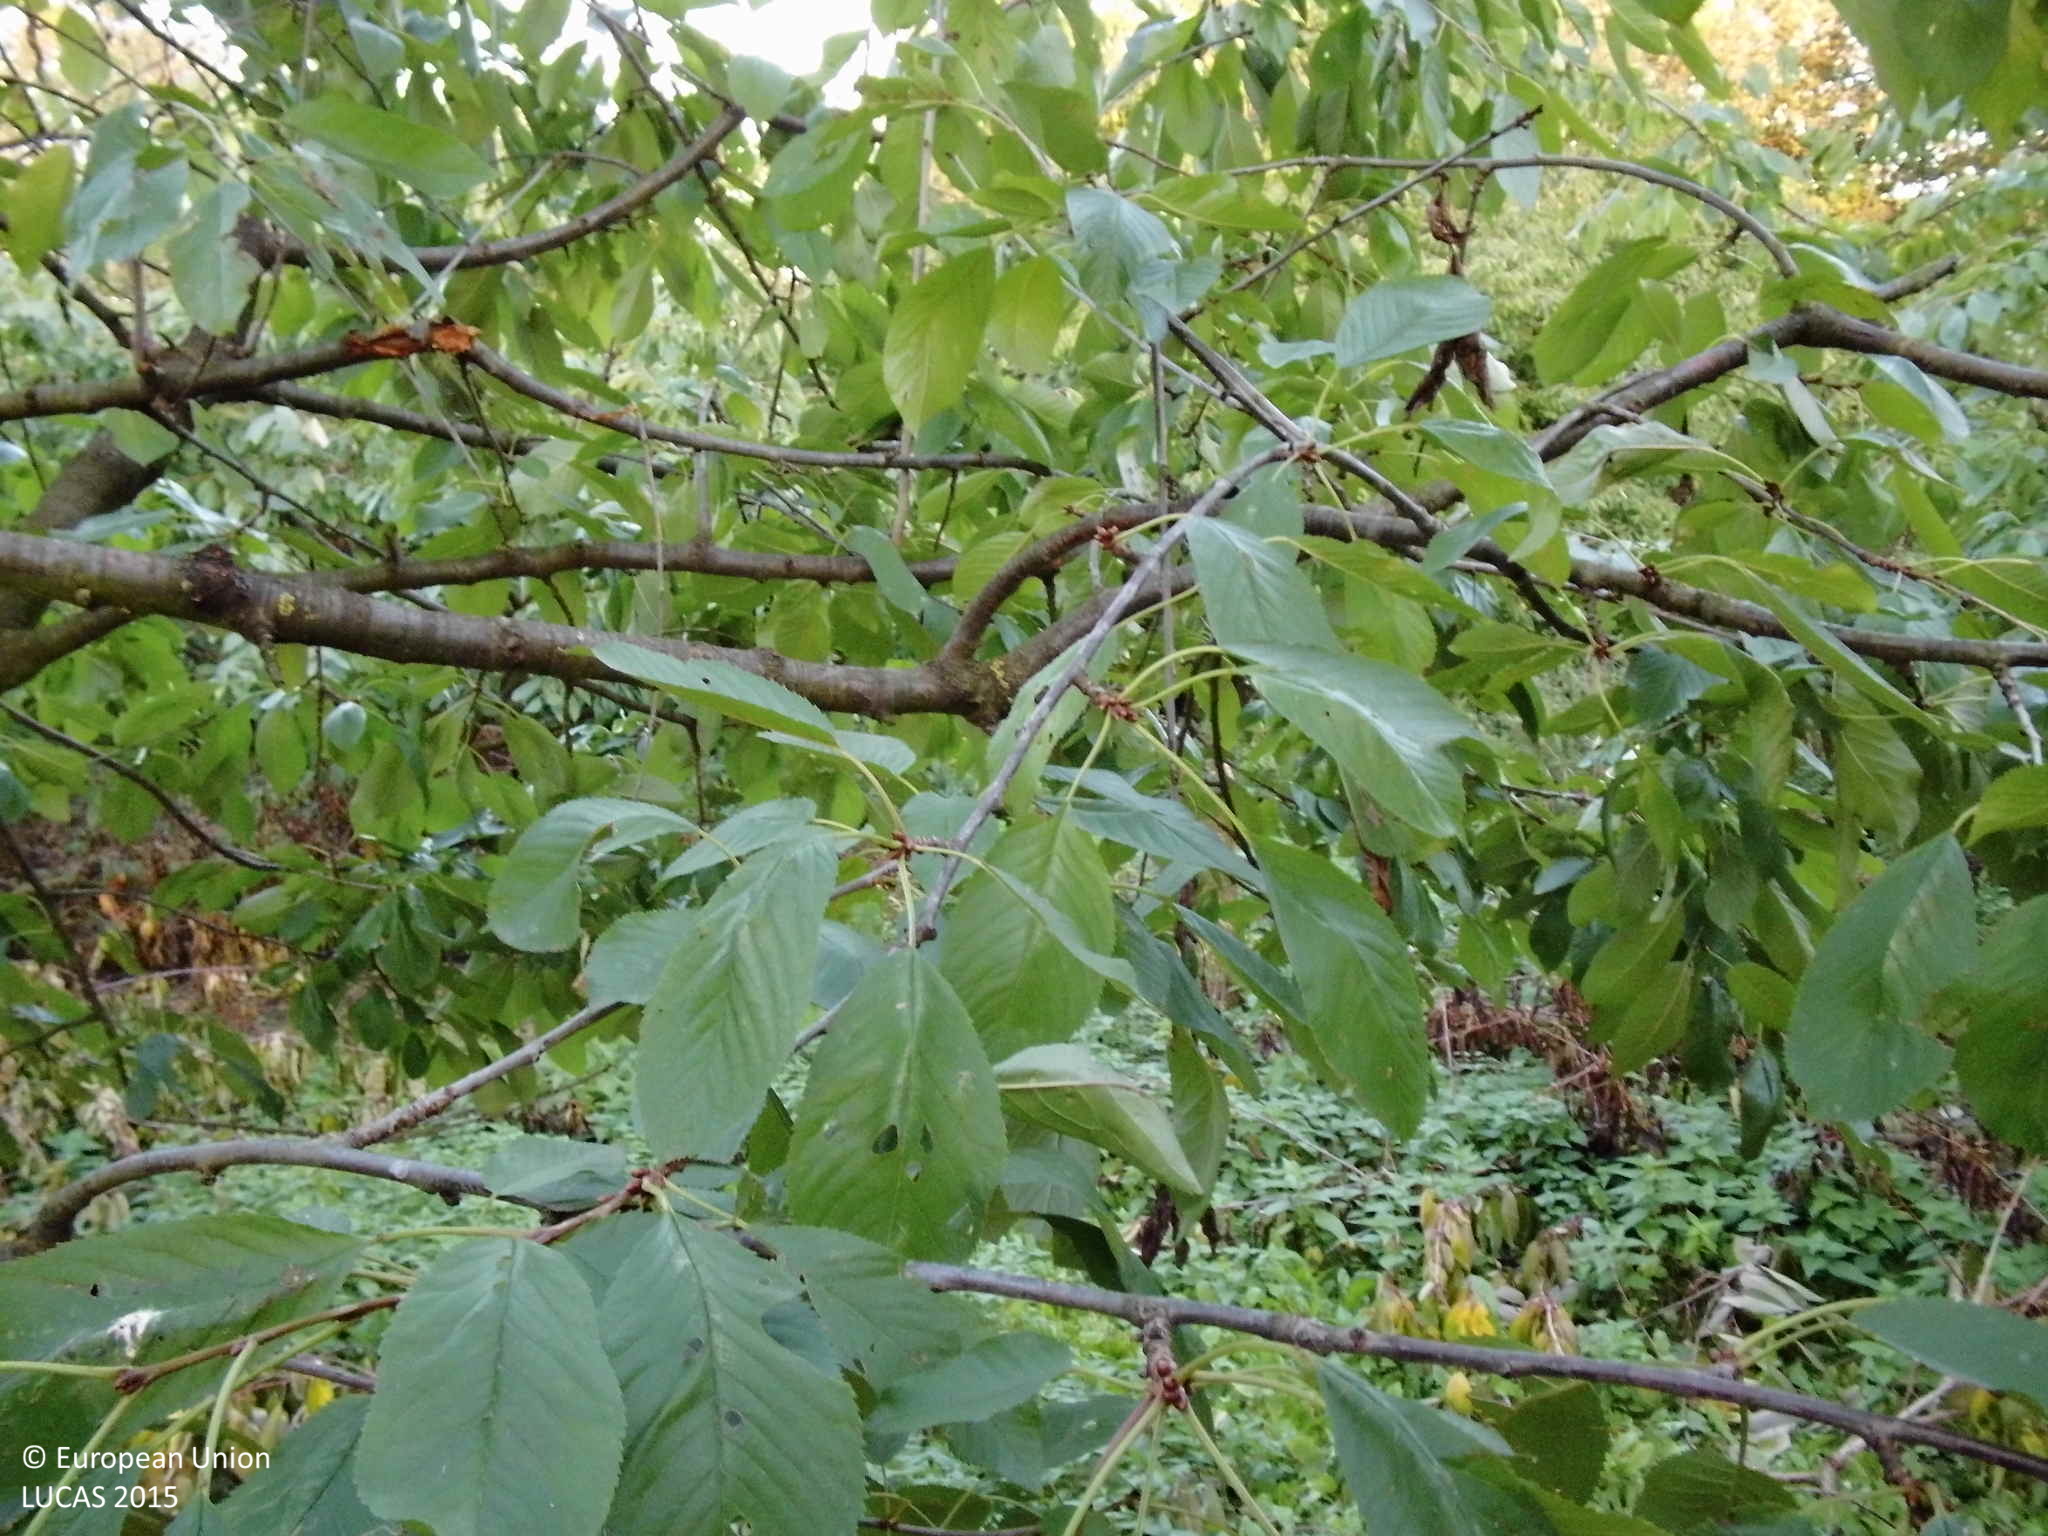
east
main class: Cropland
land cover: Cherry fruit
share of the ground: > 75 %
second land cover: Grassland without tree/shrub cover
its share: > 75 %
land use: Agriculture (excluding fallow land and kitchen gardens)
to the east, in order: Cherry fruit; Grassland without tree/shrub cover; Broadleaved woodland; Artificial constructions in urban areas
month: September
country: DE
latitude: 50.3897
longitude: 7.4544
